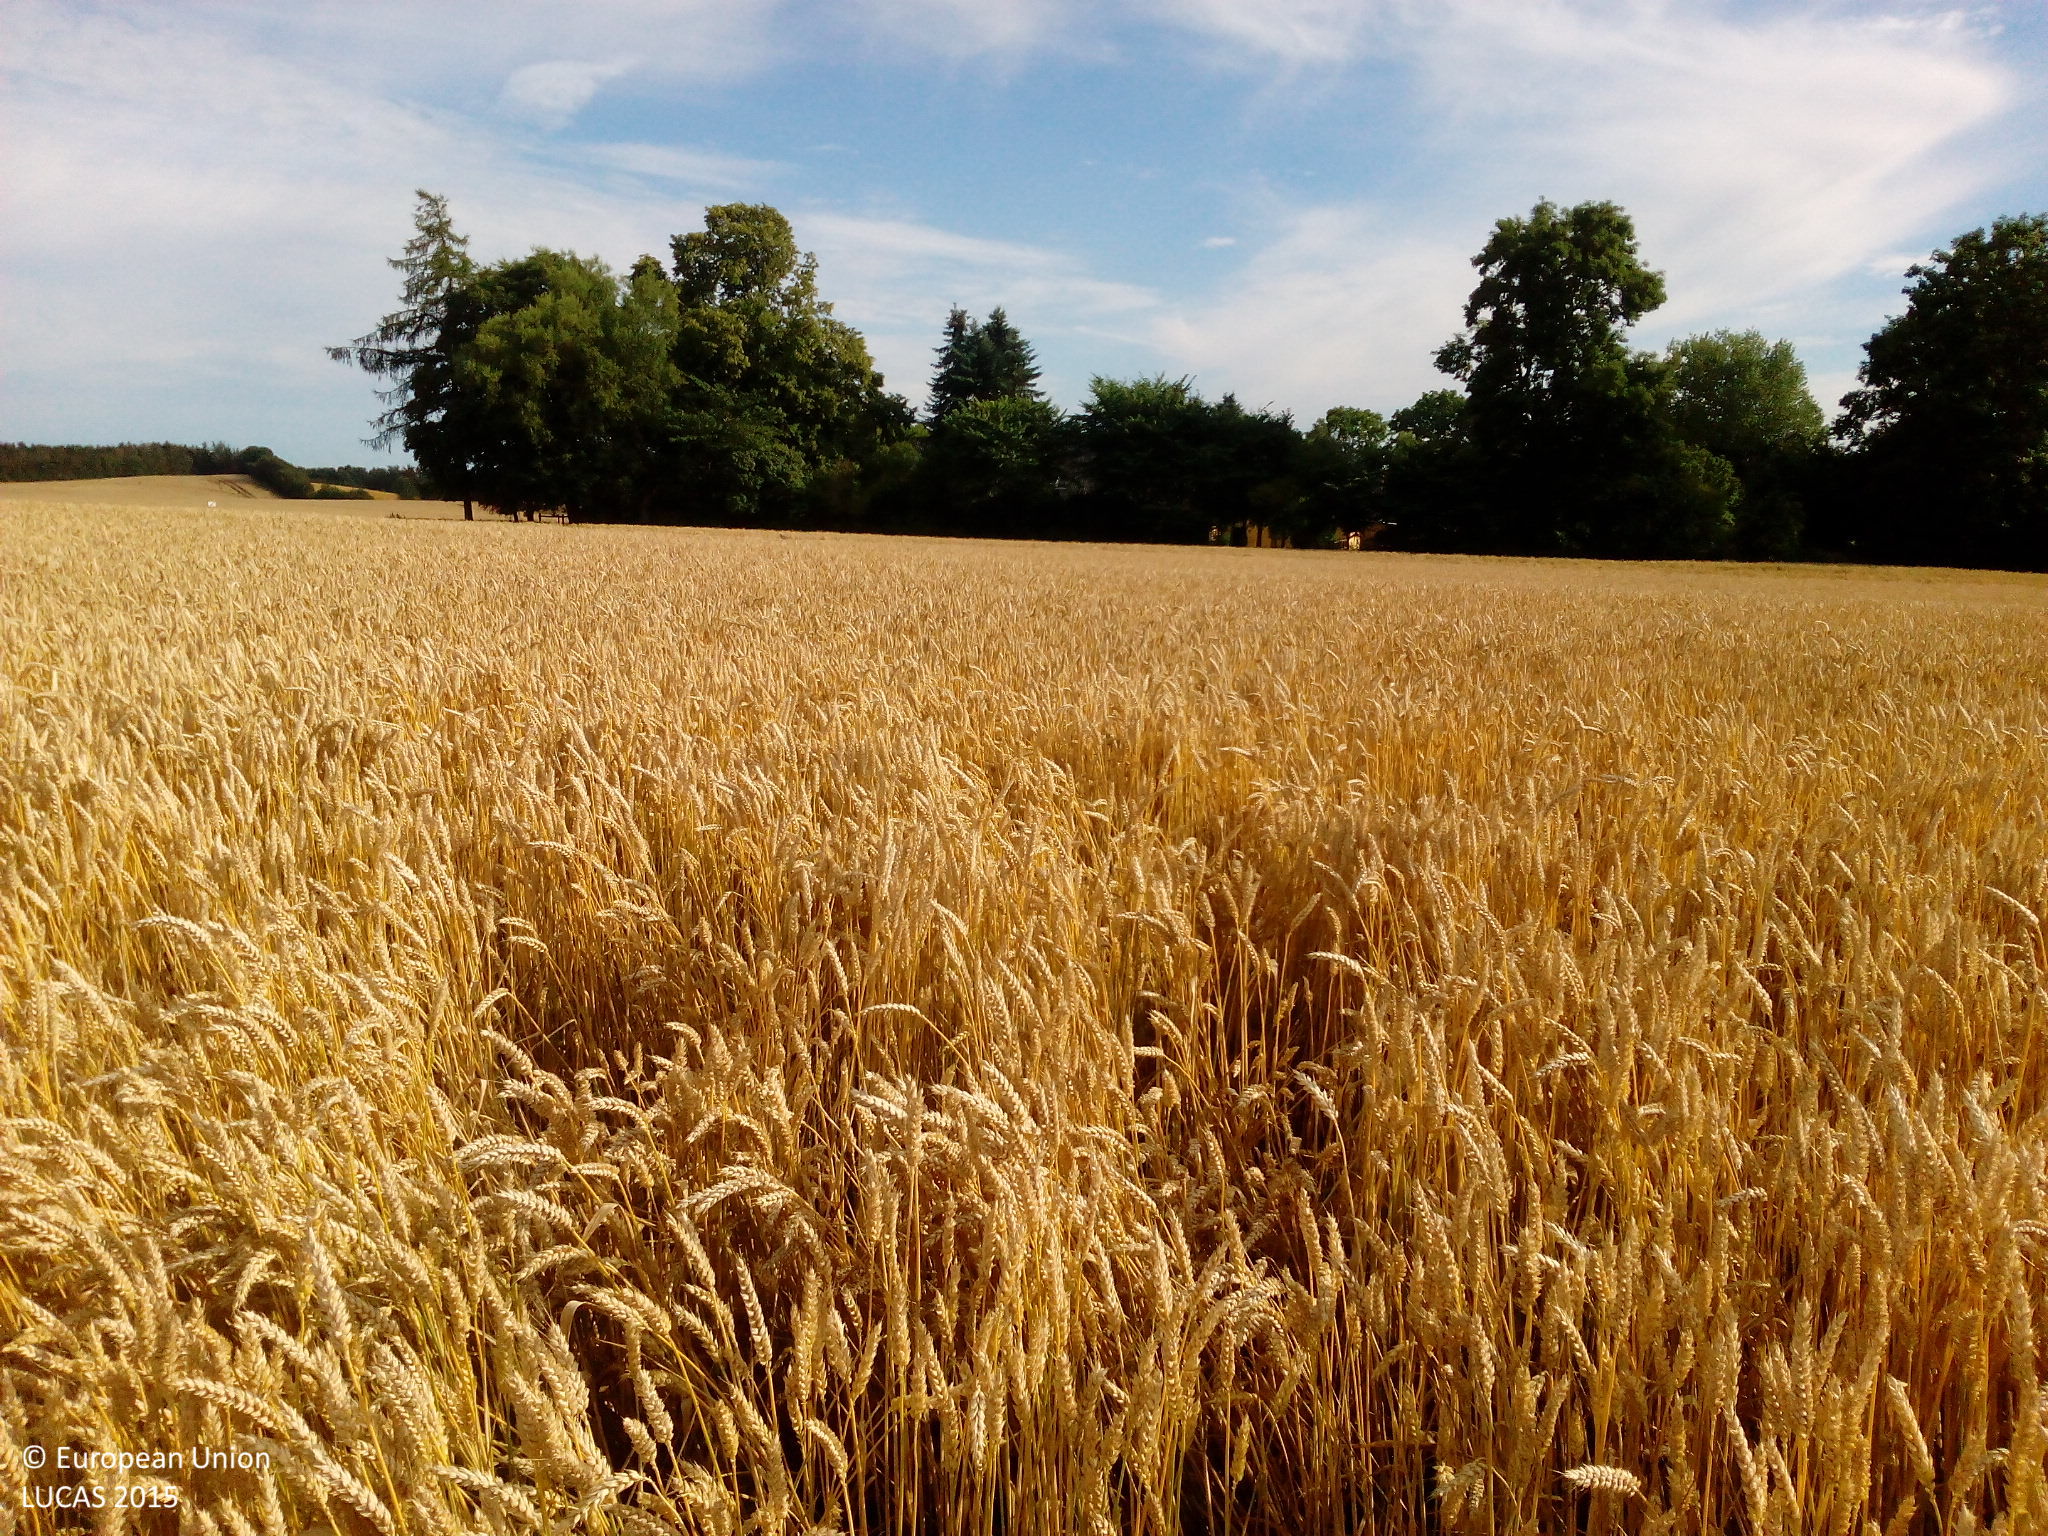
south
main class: Cropland
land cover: Common wheat
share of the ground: > 75 %
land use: Agriculture (excluding fallow land and kitchen gardens)
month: August
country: DK
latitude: 55.6016
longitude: 11.6650
